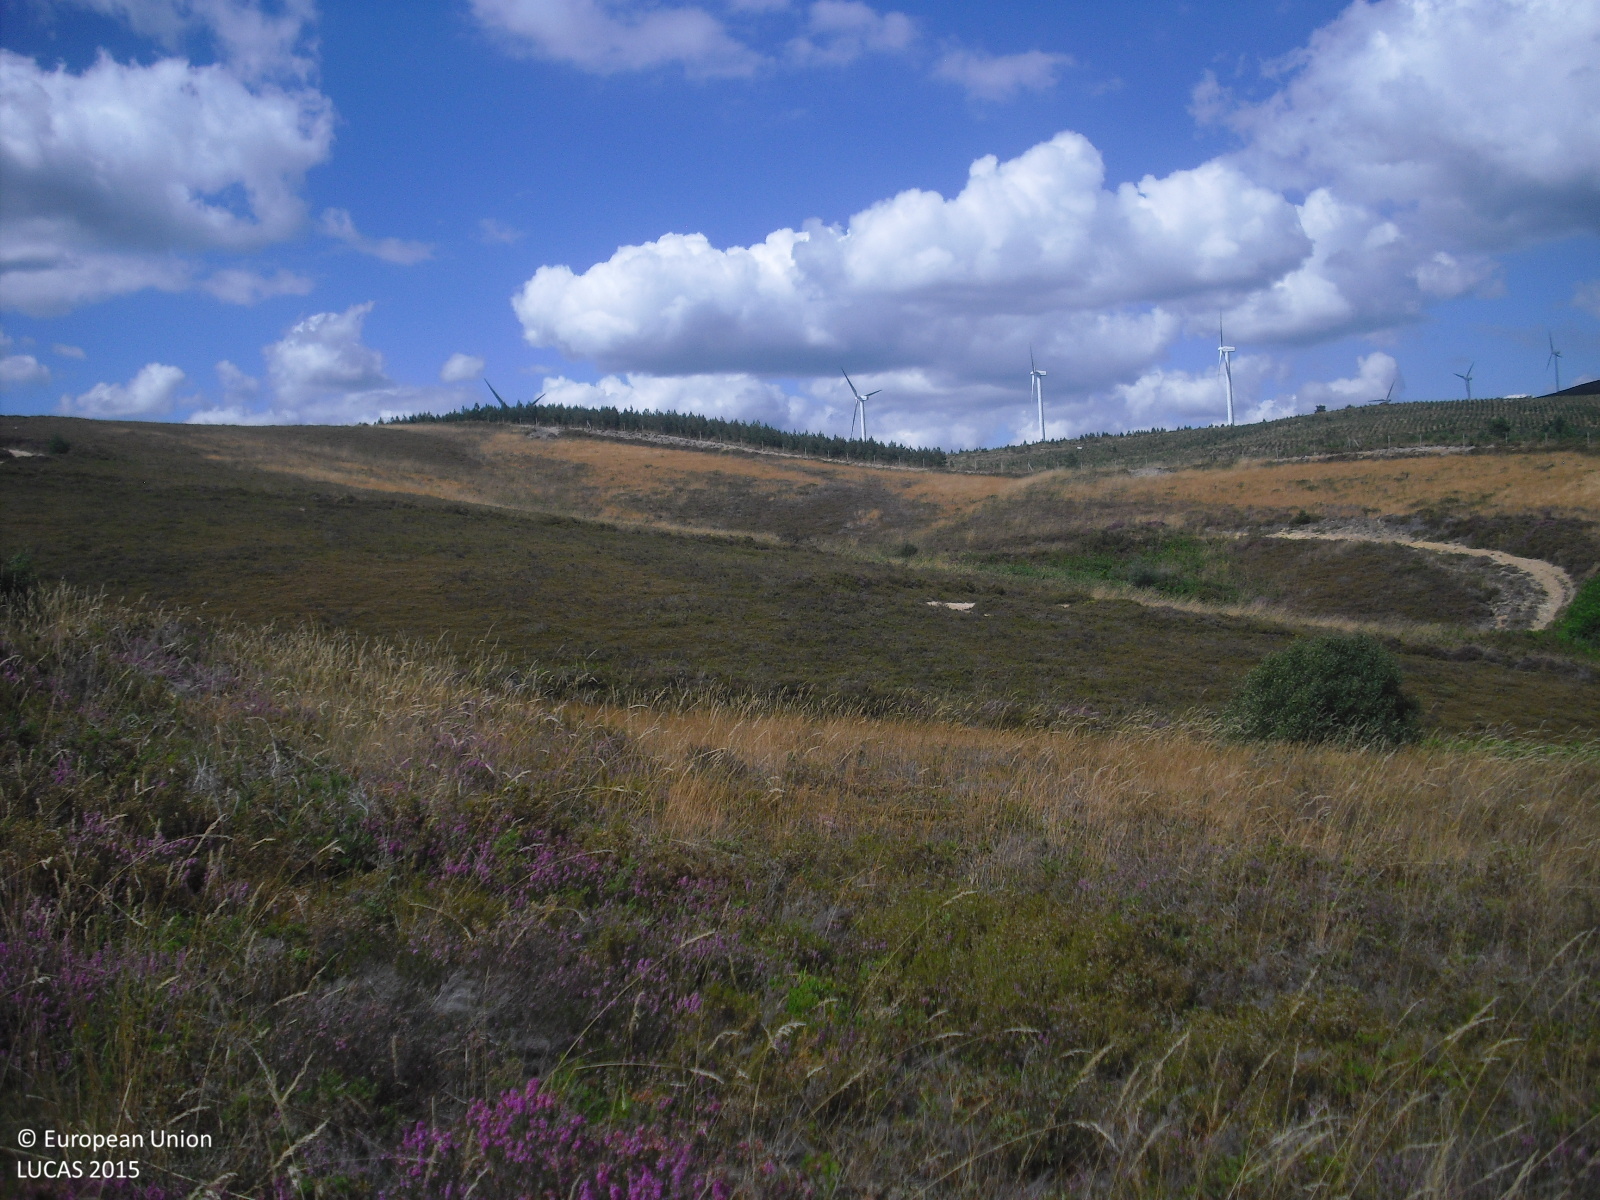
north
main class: Shrubland
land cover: Shrubland without tree cover
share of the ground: > 75 %
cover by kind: shrubs 80 %, unconsolidated bare surface 20 %
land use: Sport
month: July
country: ES
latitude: 42.3594
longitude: -7.6646
